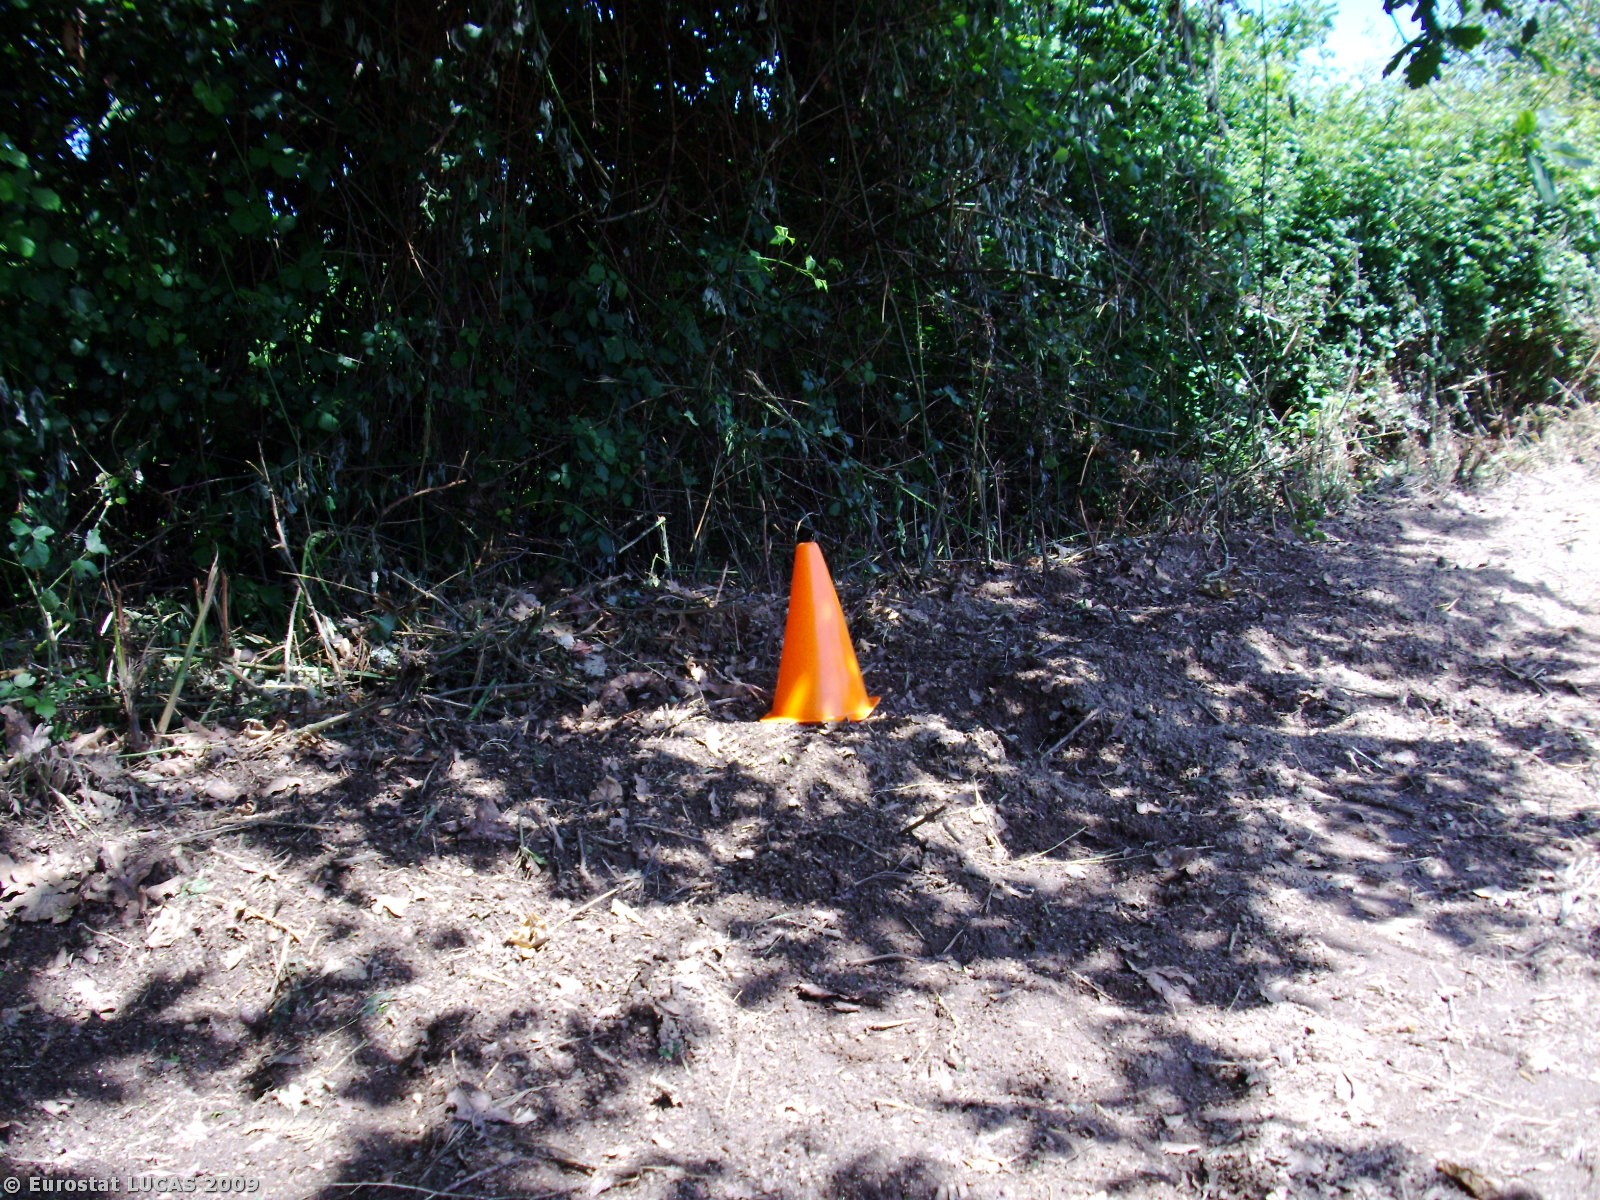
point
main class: Shrubland
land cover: Shrubland with sparse tree cover
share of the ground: > 75 %
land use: Fallow land
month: May
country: PT
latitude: 41.6494
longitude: -8.6162
